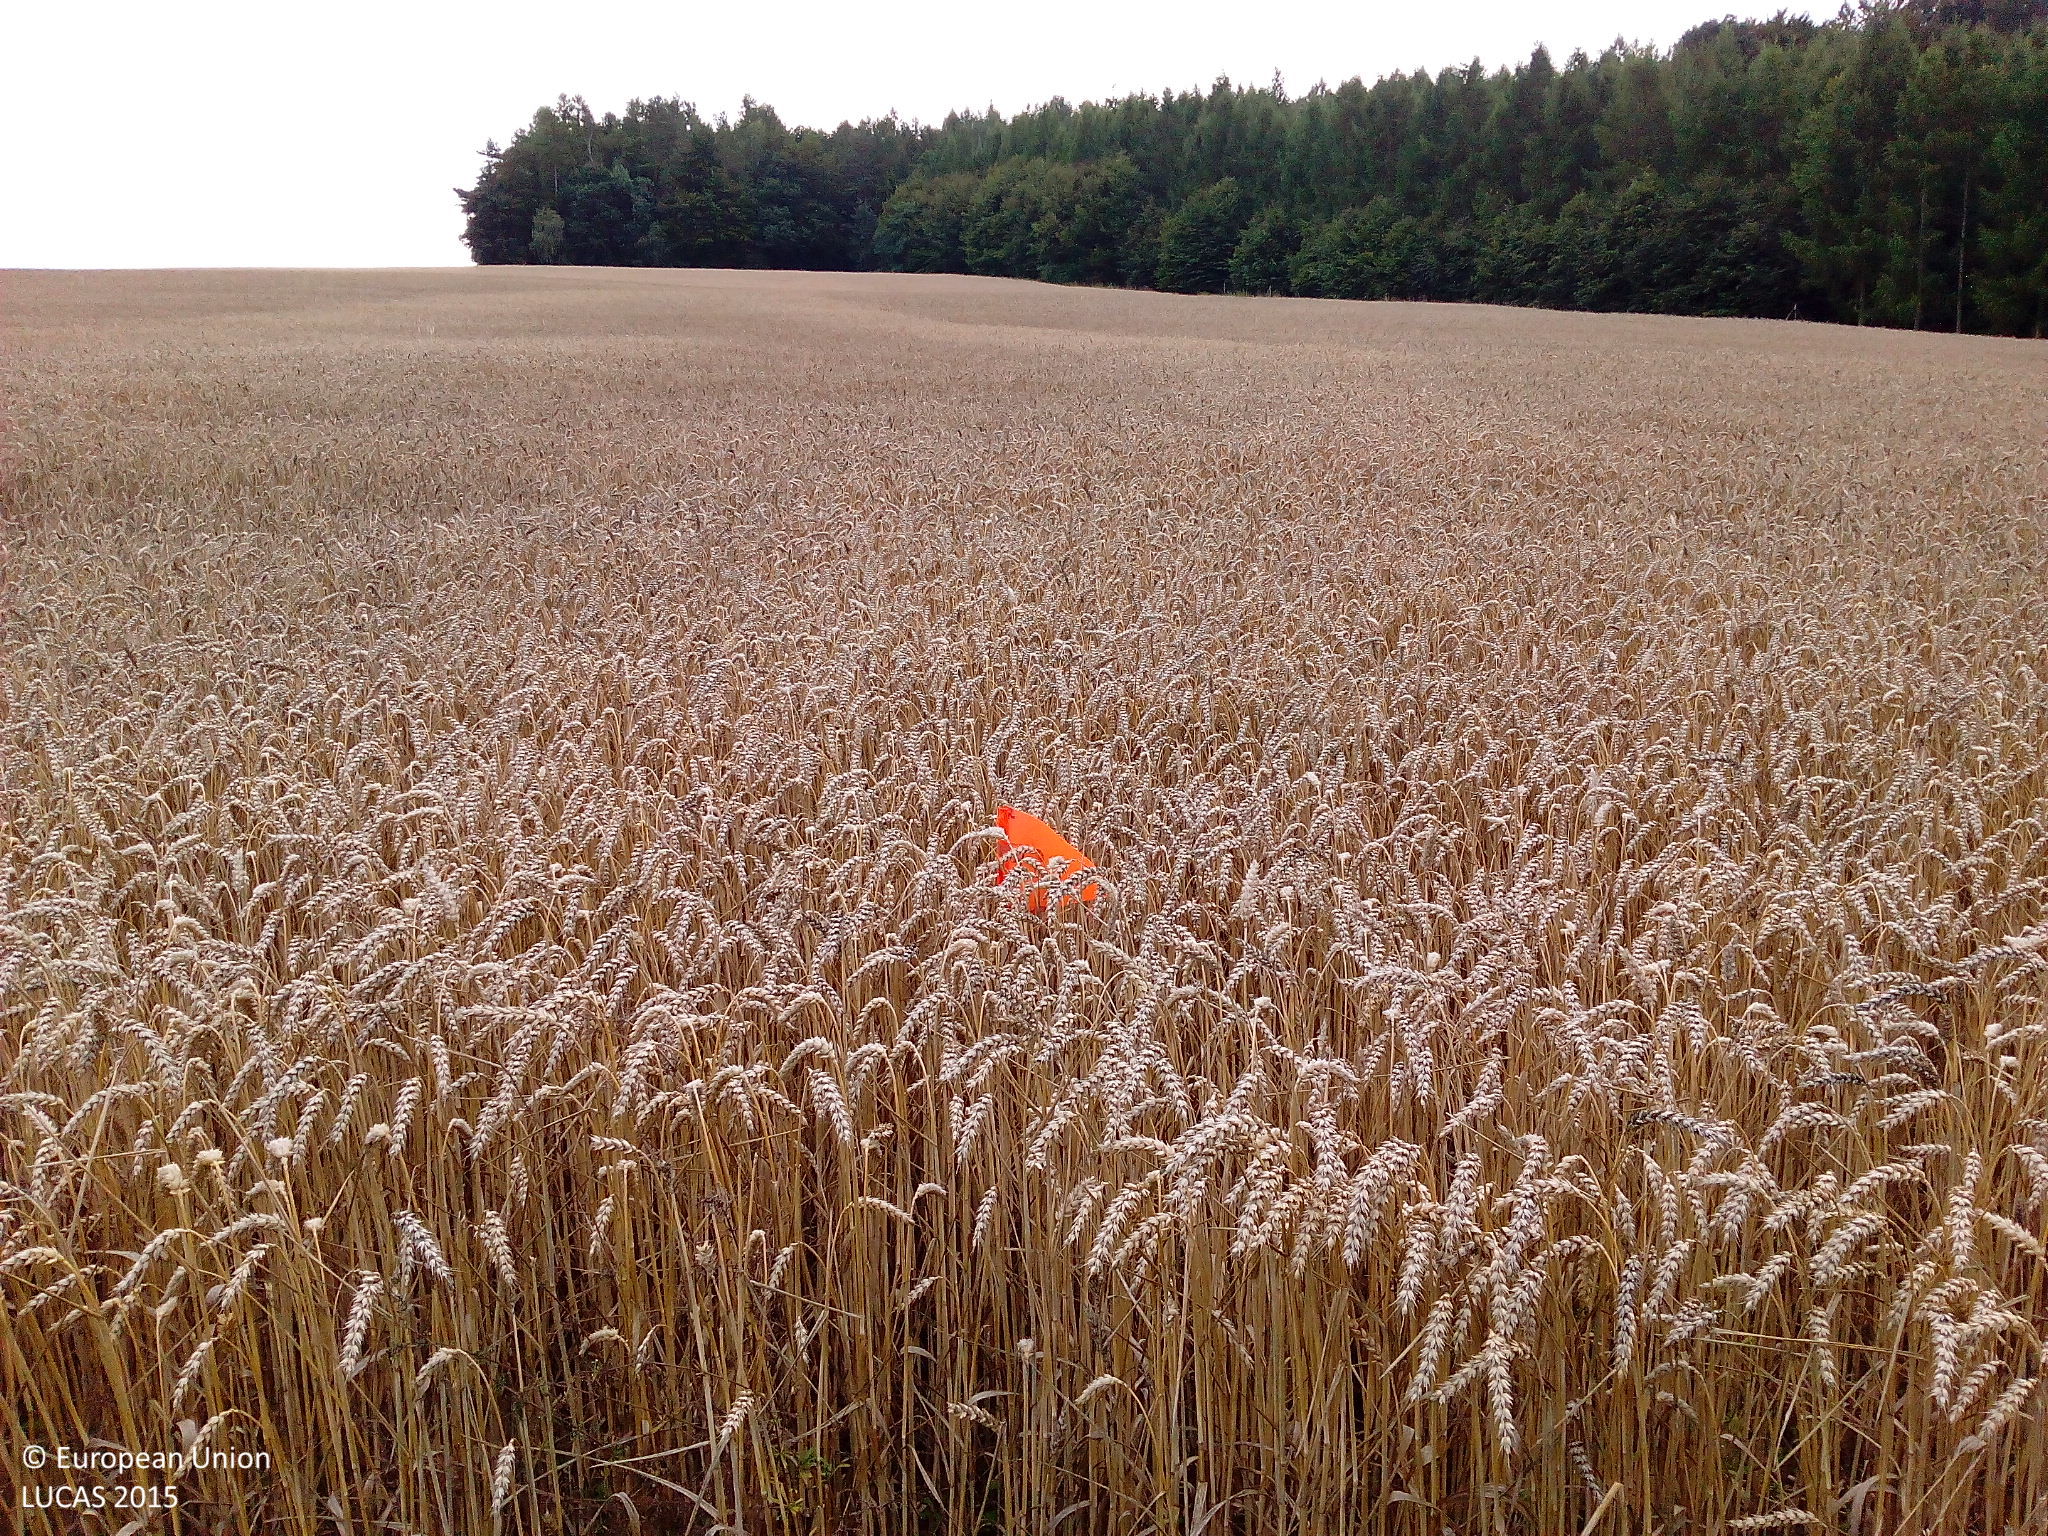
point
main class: Cropland
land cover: Common wheat
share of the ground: > 75 %
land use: Agriculture (excluding fallow land and kitchen gardens)
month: August
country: DE
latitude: 50.7409
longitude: 9.5892
